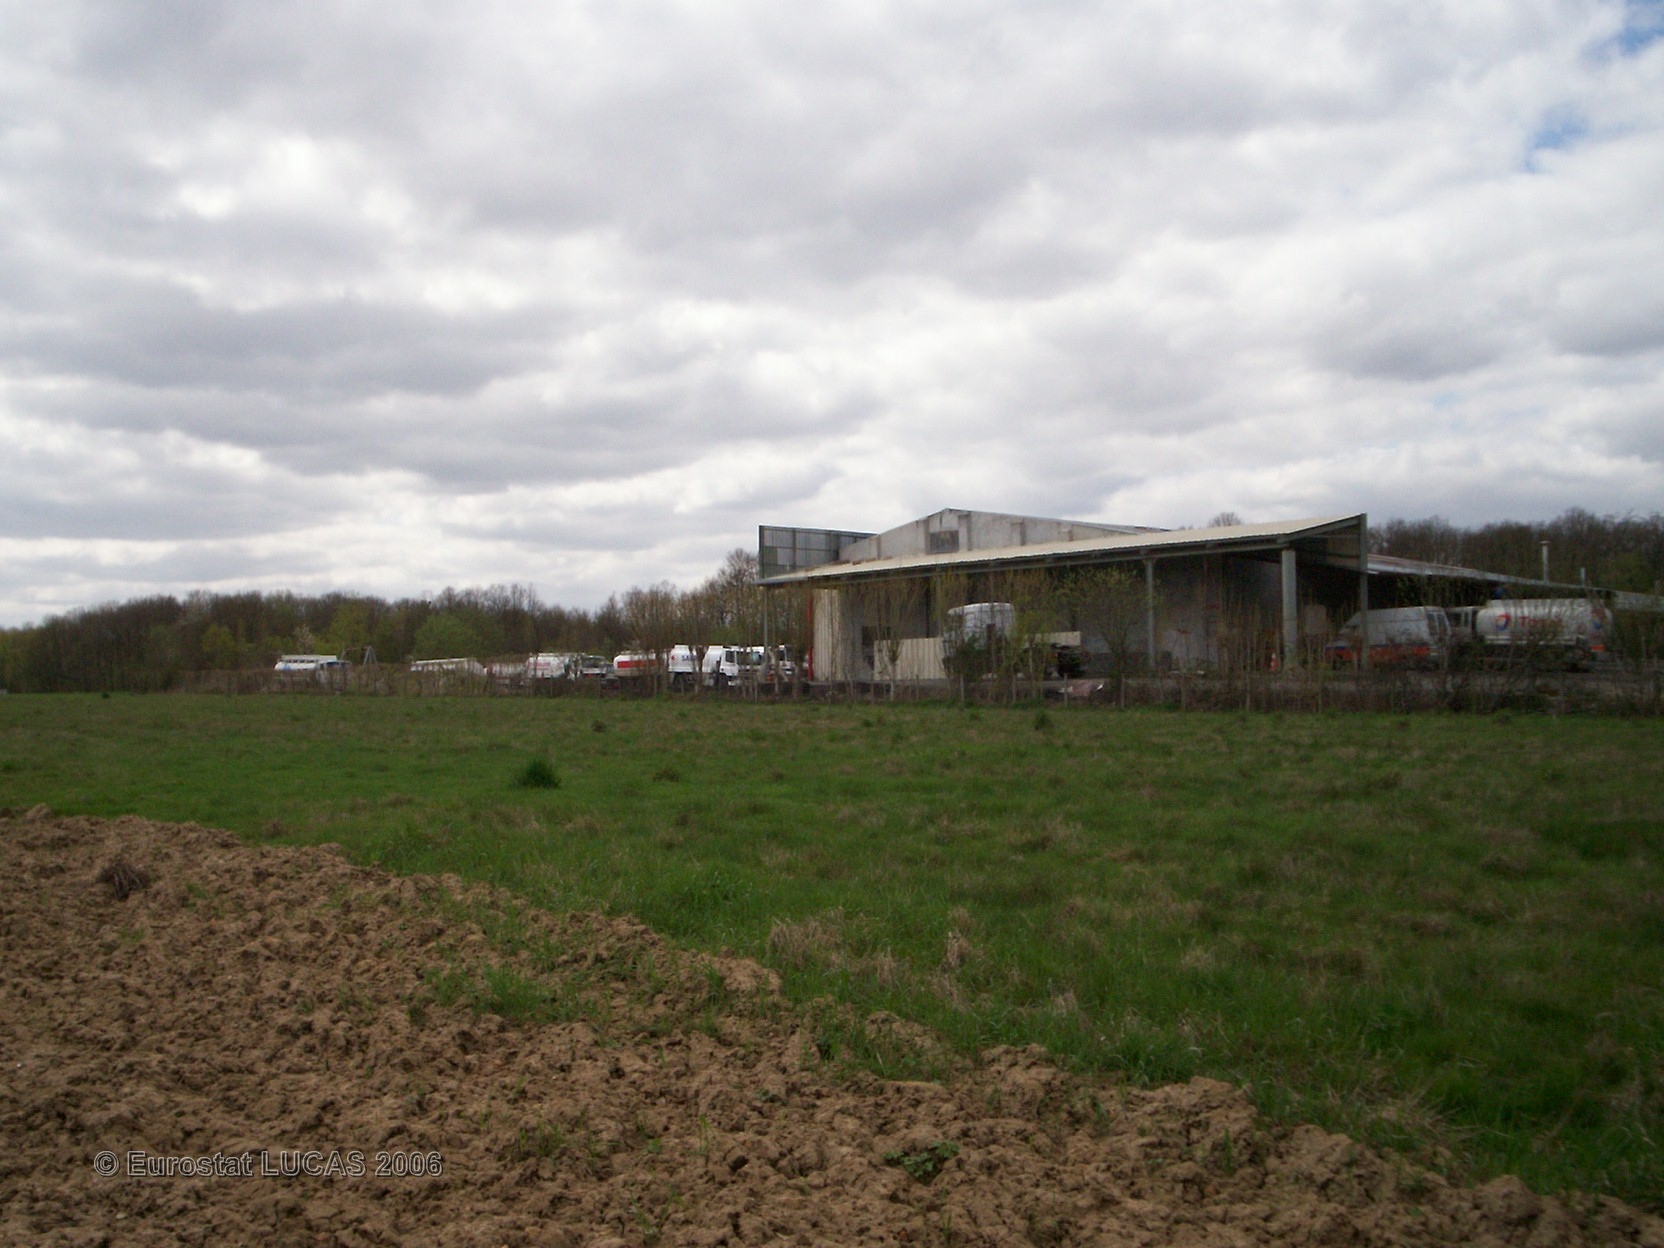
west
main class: Cropland
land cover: Maize
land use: Agriculture (excluding fallow land and kitchen gardens)
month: May
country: FR
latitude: 48.5530
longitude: 2.8786
